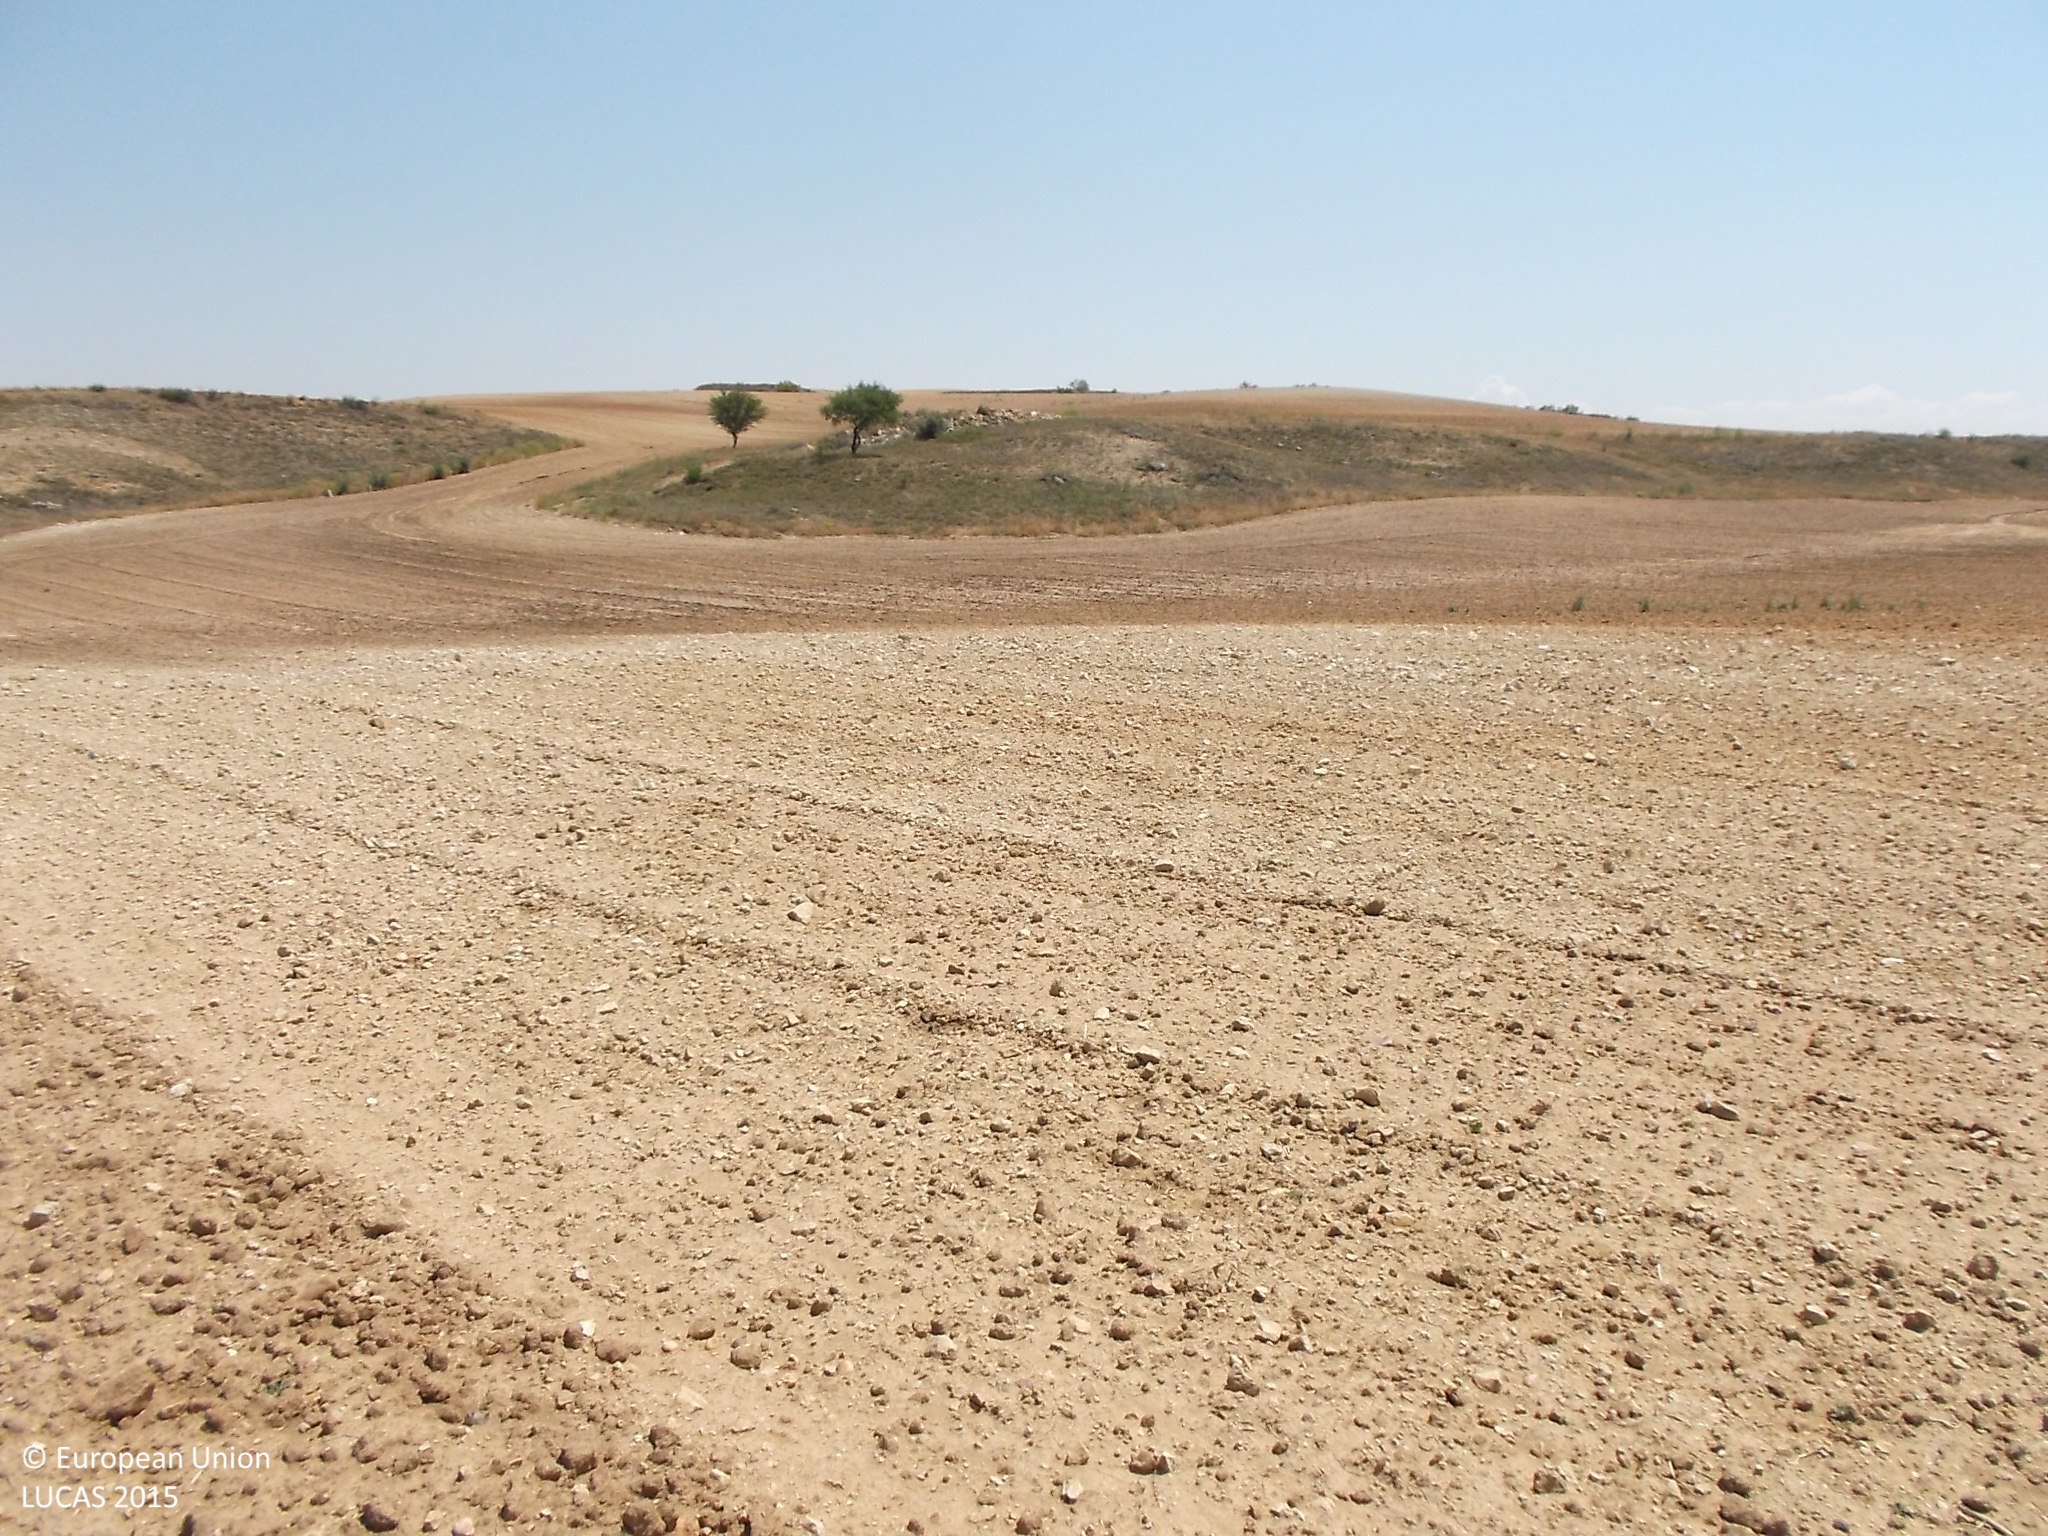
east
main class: Cropland
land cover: Common wheat
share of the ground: > 75 %
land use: Agriculture (excluding fallow land and kitchen gardens)
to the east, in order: Common wheat; Other bare soil; Grassland with sparse tree/shrub cover; Grassland without tree/shrub cover; Other bare soil
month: June
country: ES
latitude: 41.3485
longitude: -5.4604
